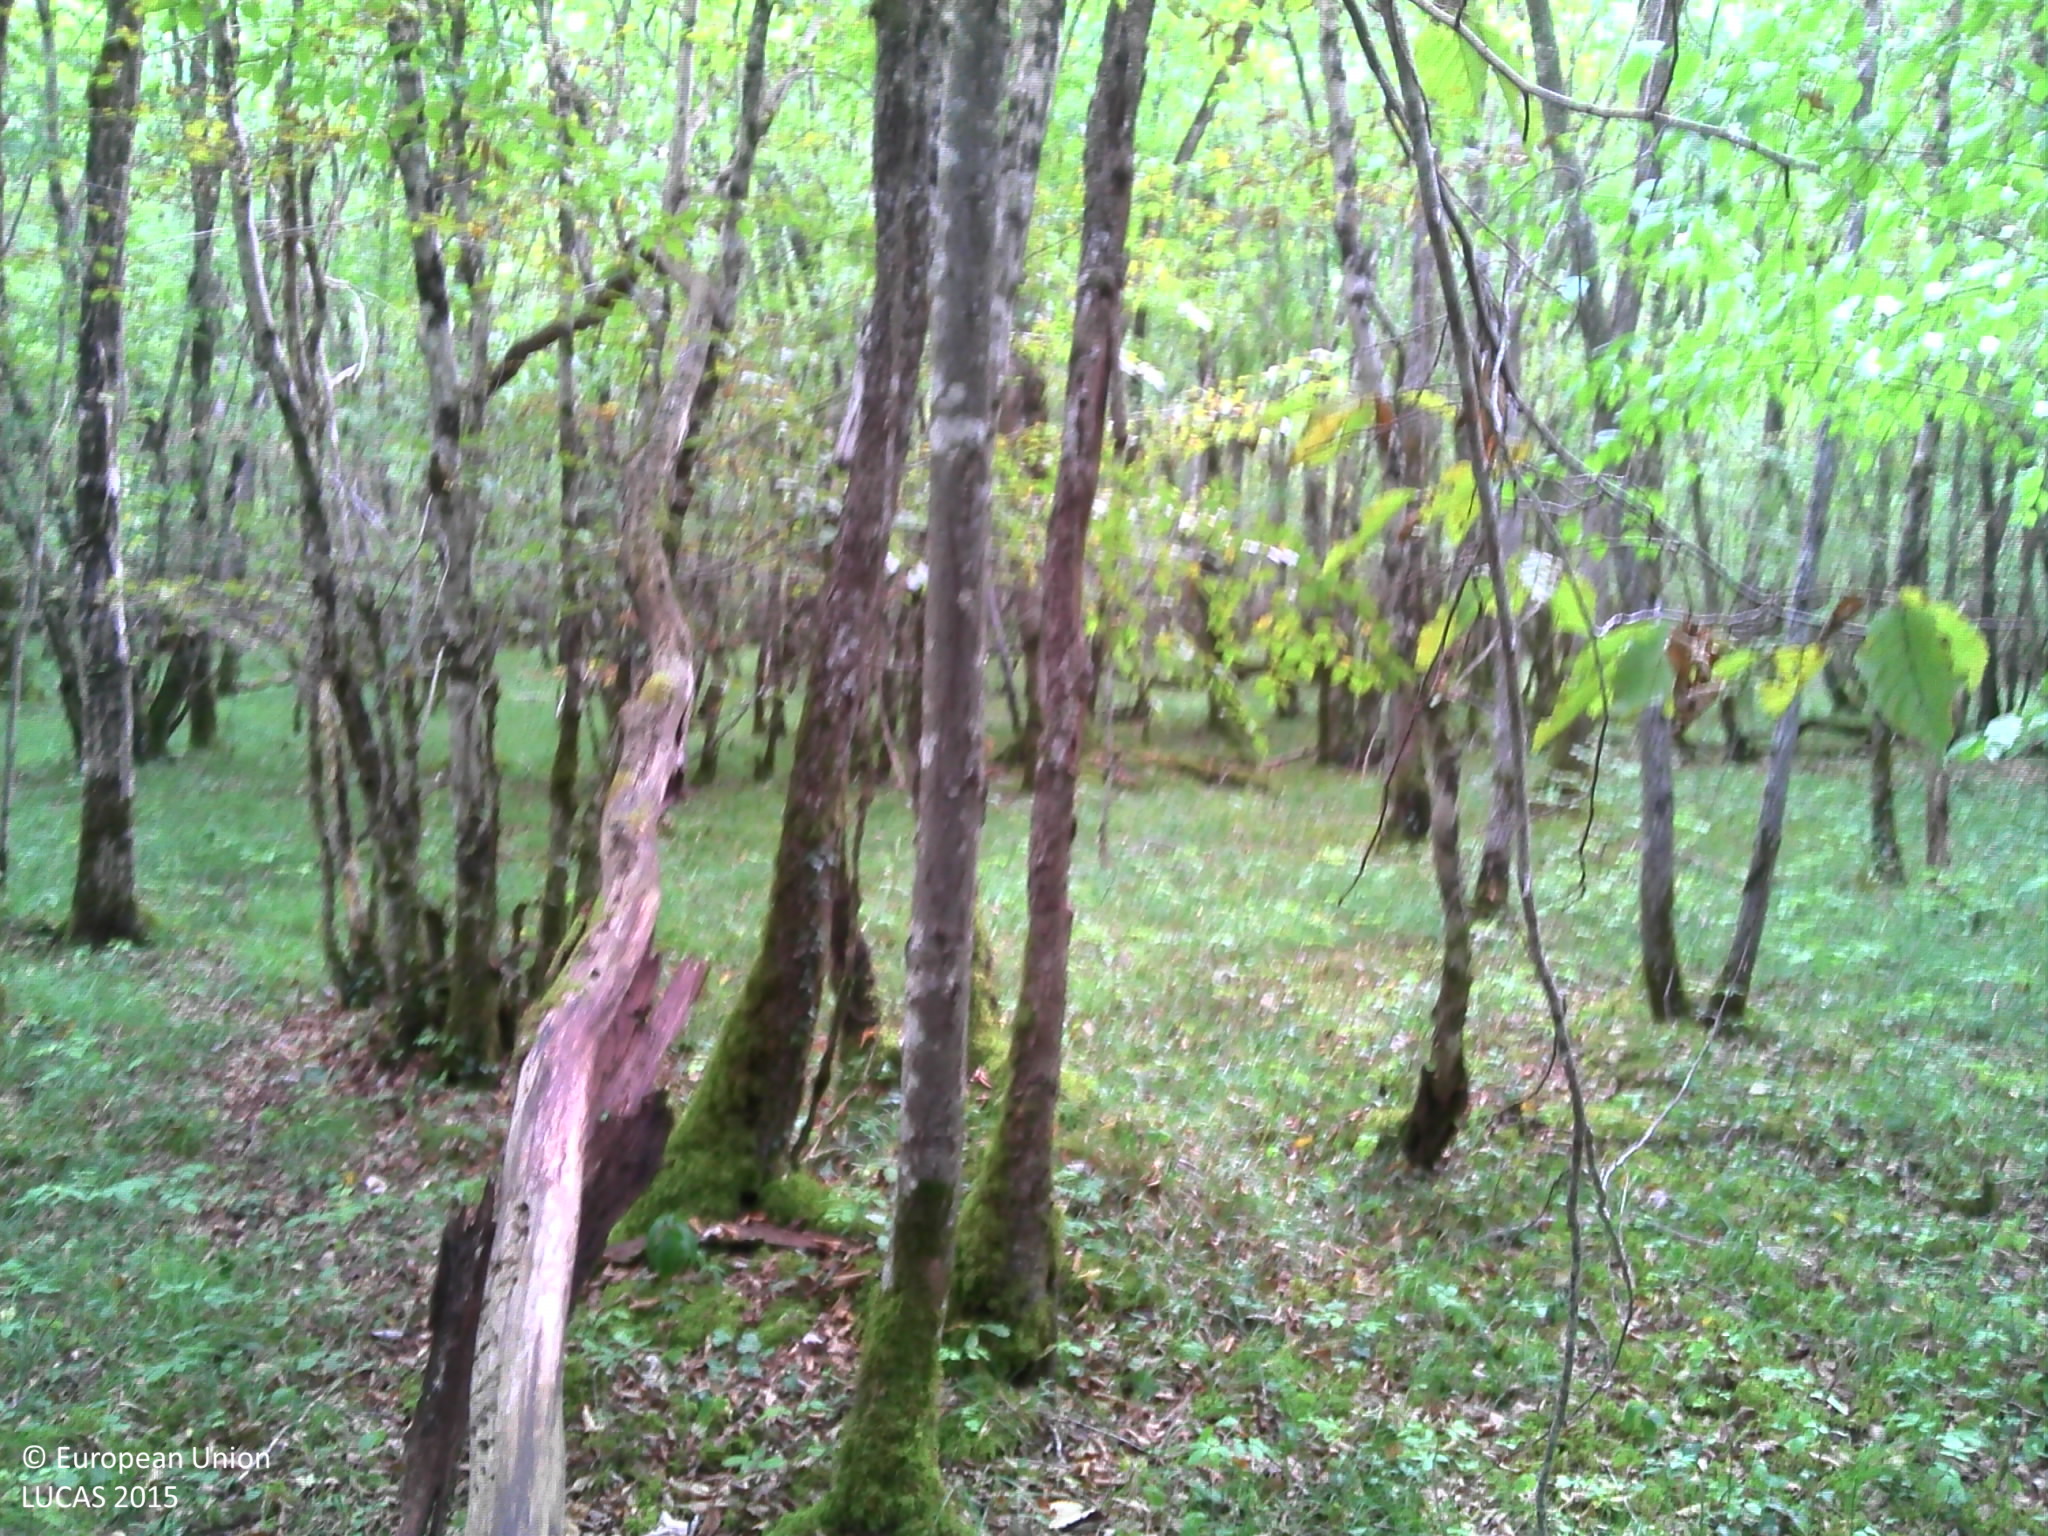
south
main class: Woodland
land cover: Broadleaved woodland
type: mesophytic deciduous forest
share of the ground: > 75 %
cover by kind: broadleaved forest trees 90 %, herbaceous plants 5 %, lichens and mosses 5 %
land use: Forestry
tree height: > 5 m
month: September
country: FR
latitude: 47.5458
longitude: 4.8844
